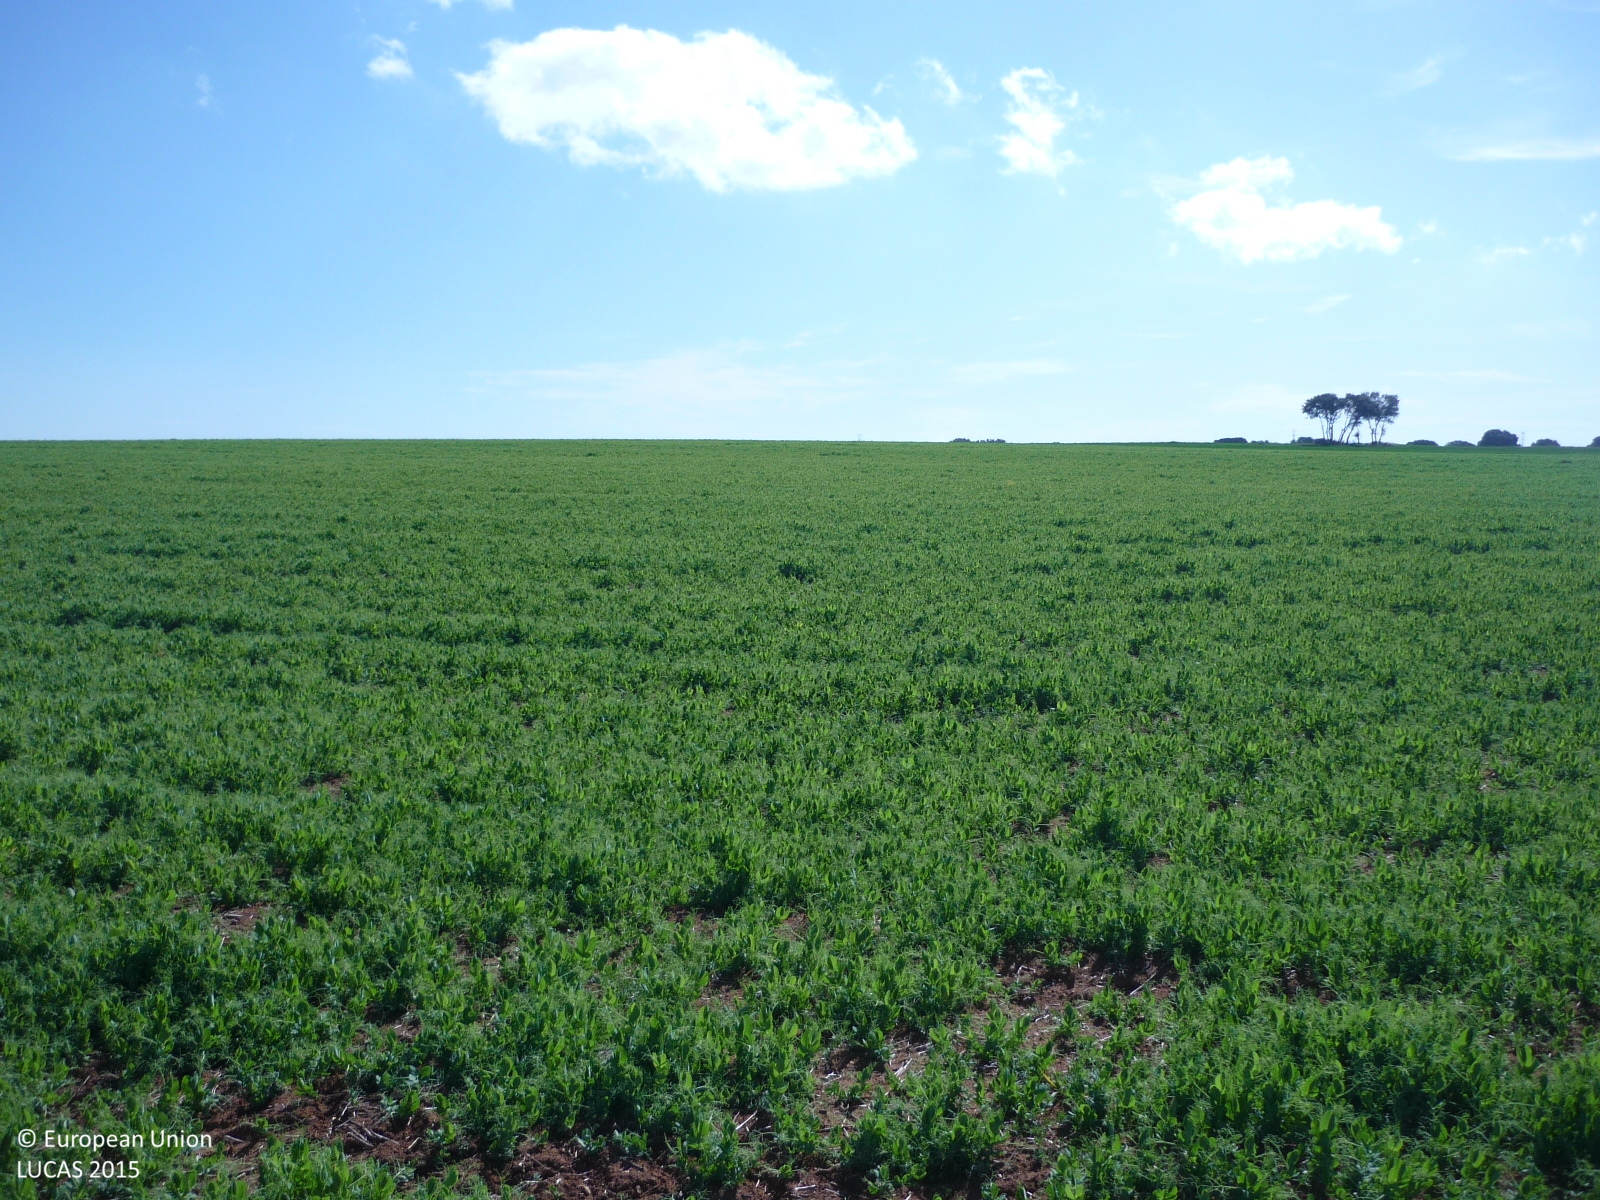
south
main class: Cropland
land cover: Dry pulses
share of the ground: > 75 %
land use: Agriculture (excluding fallow land and kitchen gardens)
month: April
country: ES
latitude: 40.4444
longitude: -3.2487
